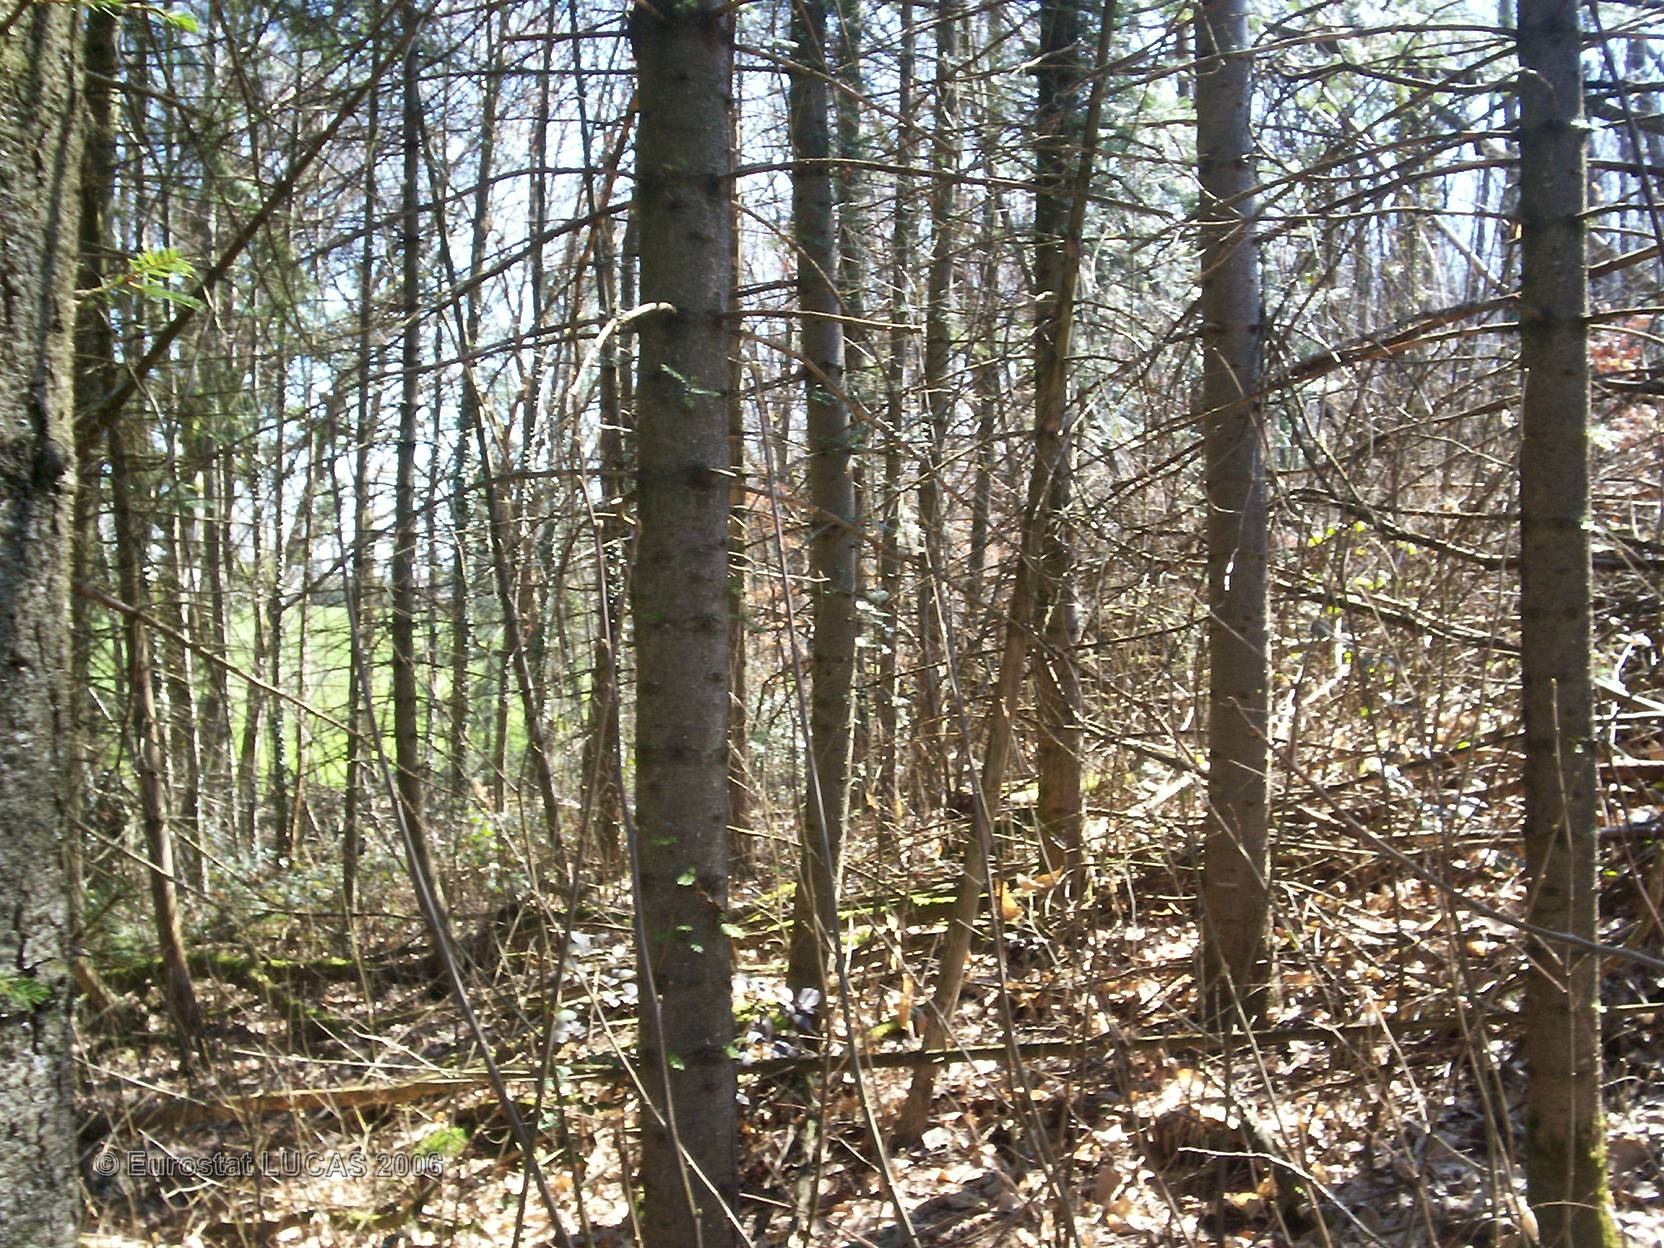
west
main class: Woodland
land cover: Mixed forest
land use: Forestry
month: April
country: FR
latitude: 45.3889
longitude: 1.6288
